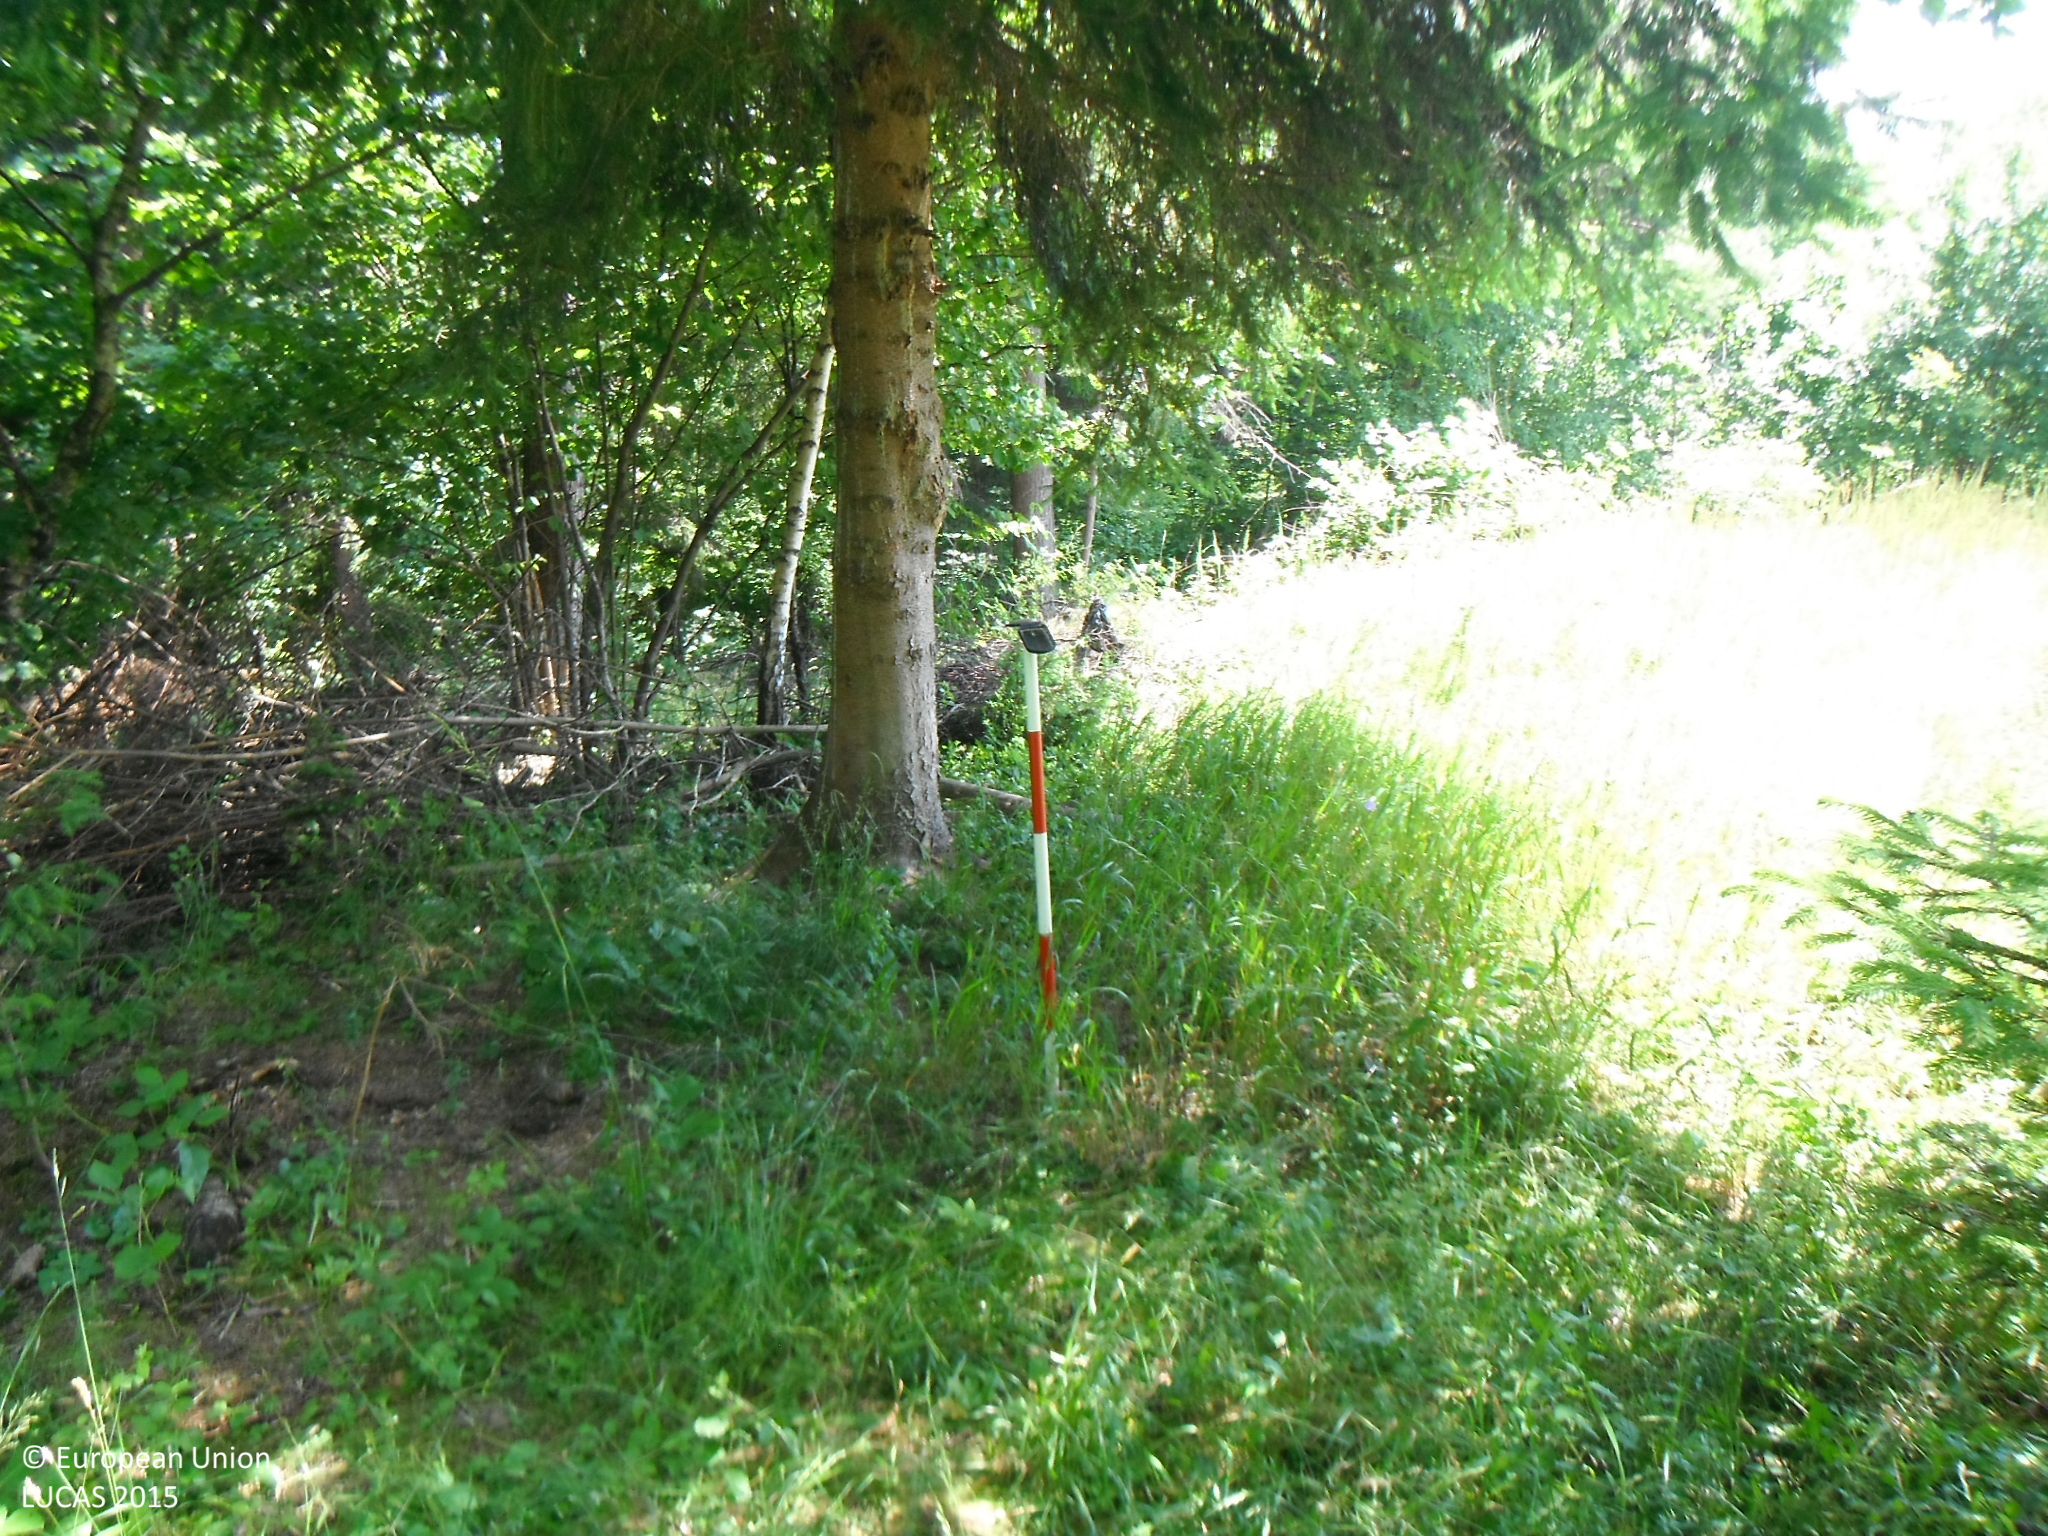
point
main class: Woodland
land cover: Spruce dominated mixed woodland
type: hemiboreal forest and nemoral coniferous forest and mixed broadleaved-coniferous forest
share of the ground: > 75 %
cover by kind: coniferous forest trees 50 %, broadleaved forest trees 25 %, herbaceous plants 15 %, shrubs 10 %
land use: Forestry
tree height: > 5 m
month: July
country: SK
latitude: 49.2698
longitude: 18.4978
